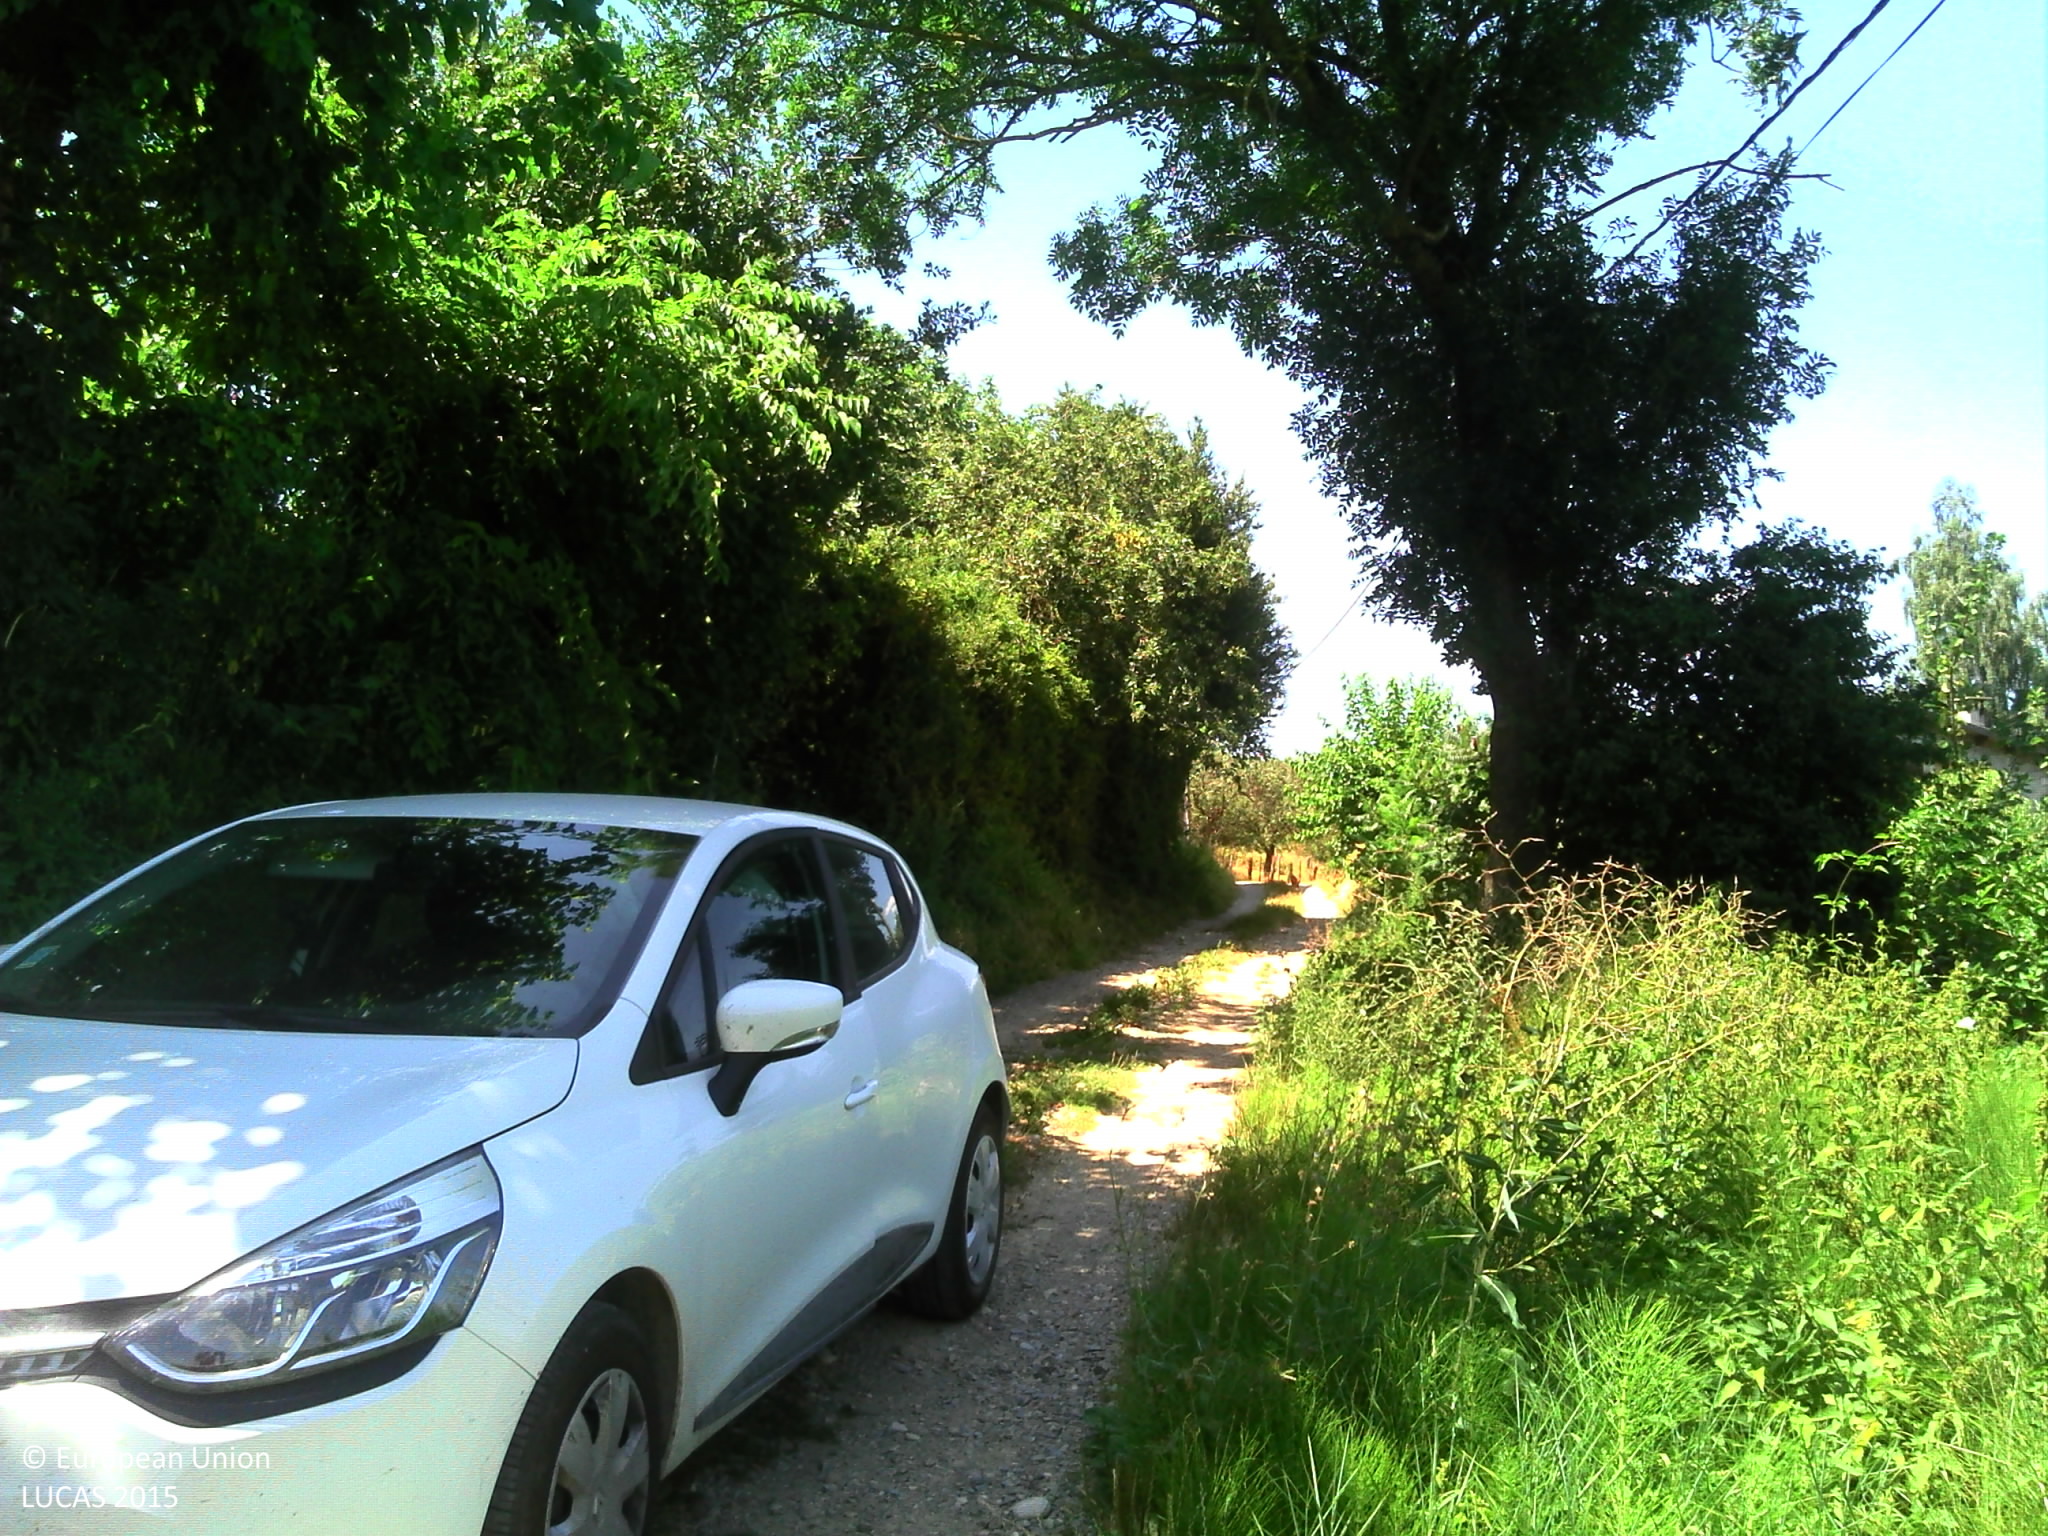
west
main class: Cropland
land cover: Maize
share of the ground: > 75 %
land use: Agriculture (excluding fallow land and kitchen gardens)
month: July
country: FR
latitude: 45.2366
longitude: 4.8968
